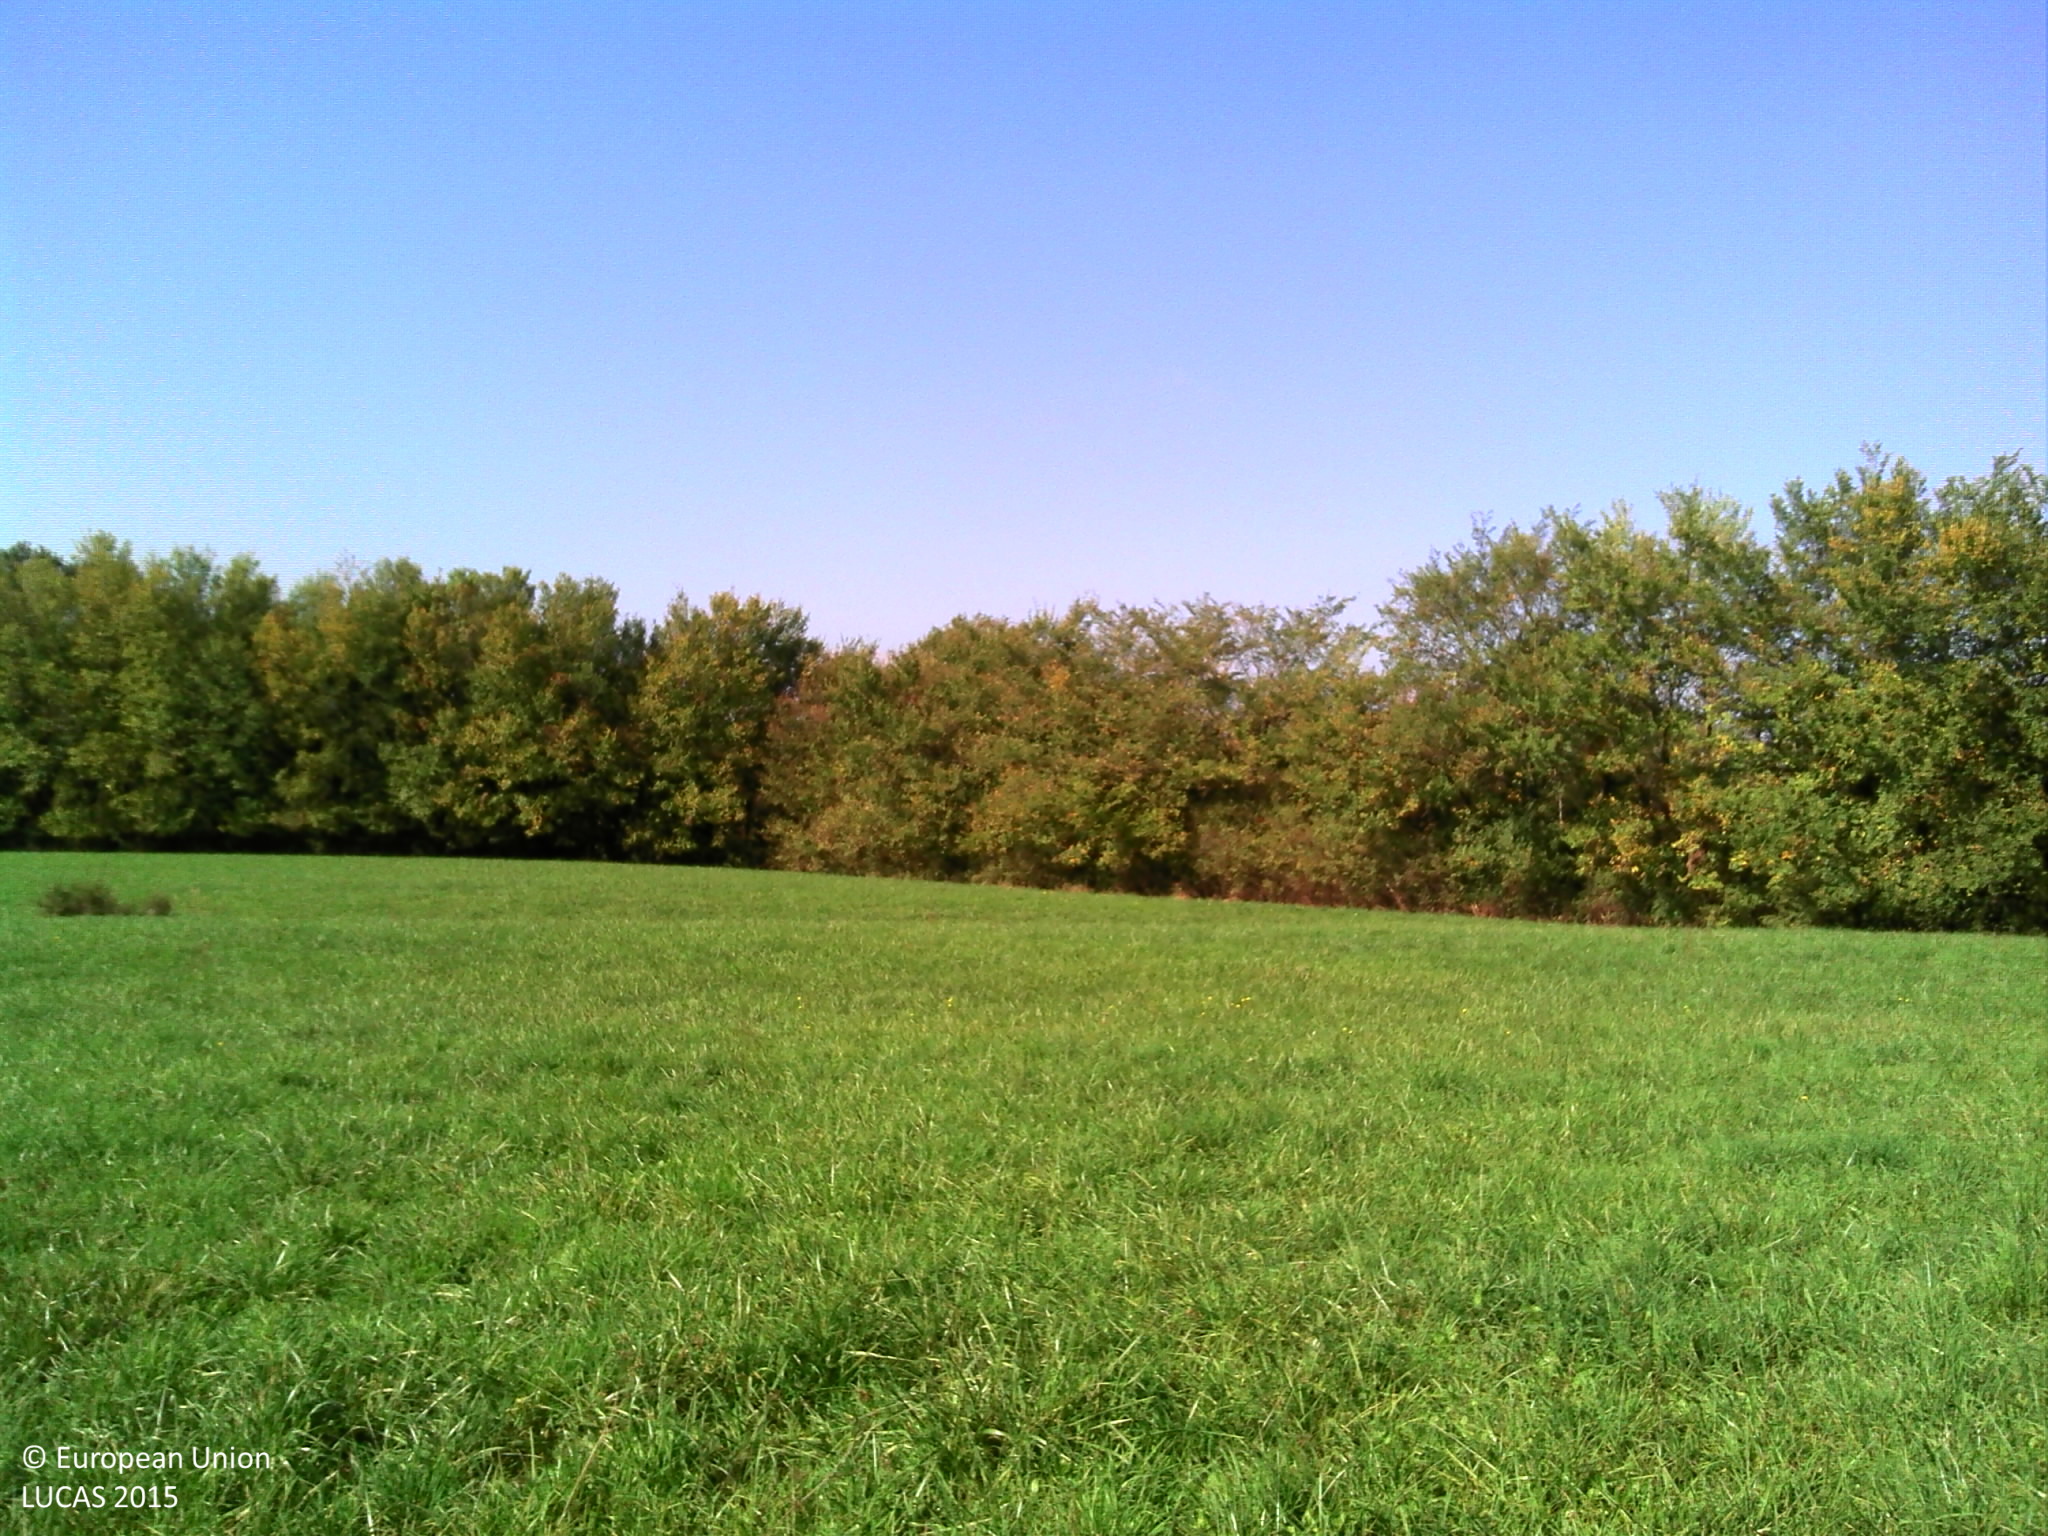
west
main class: Grassland
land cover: Grassland without tree/shrub cover
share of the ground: > 75 %
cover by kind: herbaceous plants 100 %
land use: Agriculture (excluding fallow land and kitchen gardens)
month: October
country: FR
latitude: 46.2838
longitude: 4.9017
